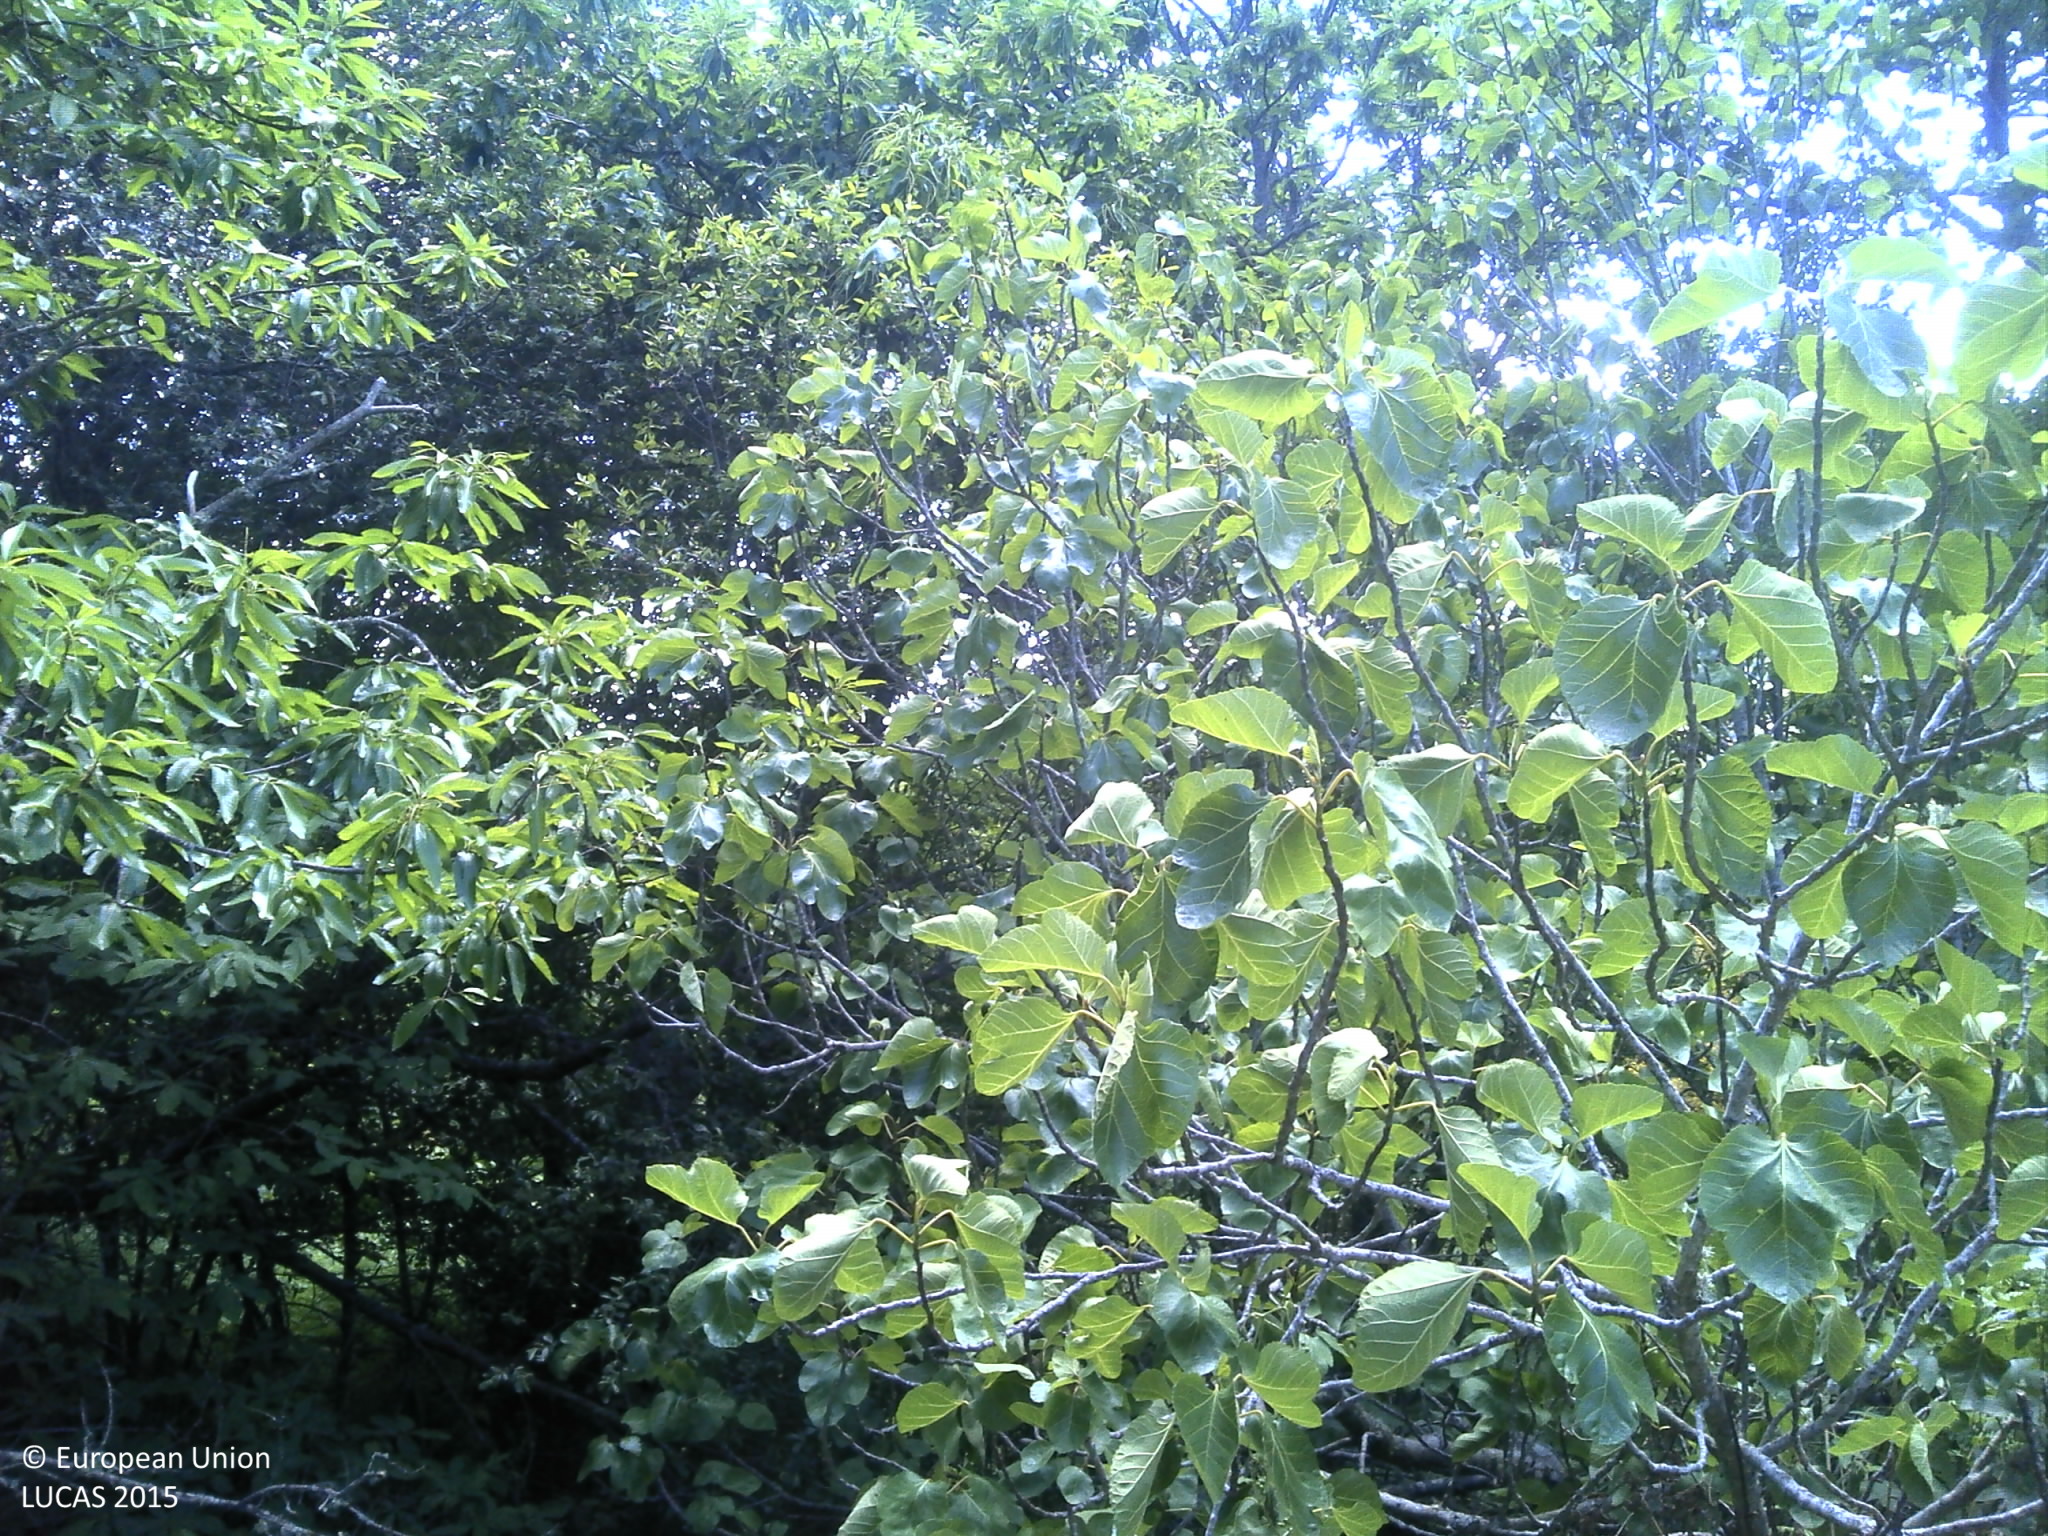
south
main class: Woodland
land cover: Broadleaved woodland
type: thermophilous deciduous forest
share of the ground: 25 - 50 %
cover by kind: shrubs 50 %, broadleaved forest trees 25 %, unconsolidated bare surface 25 %
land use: Forestry
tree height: > 5 m
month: May
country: PT
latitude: 40.4798
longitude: -7.2442
